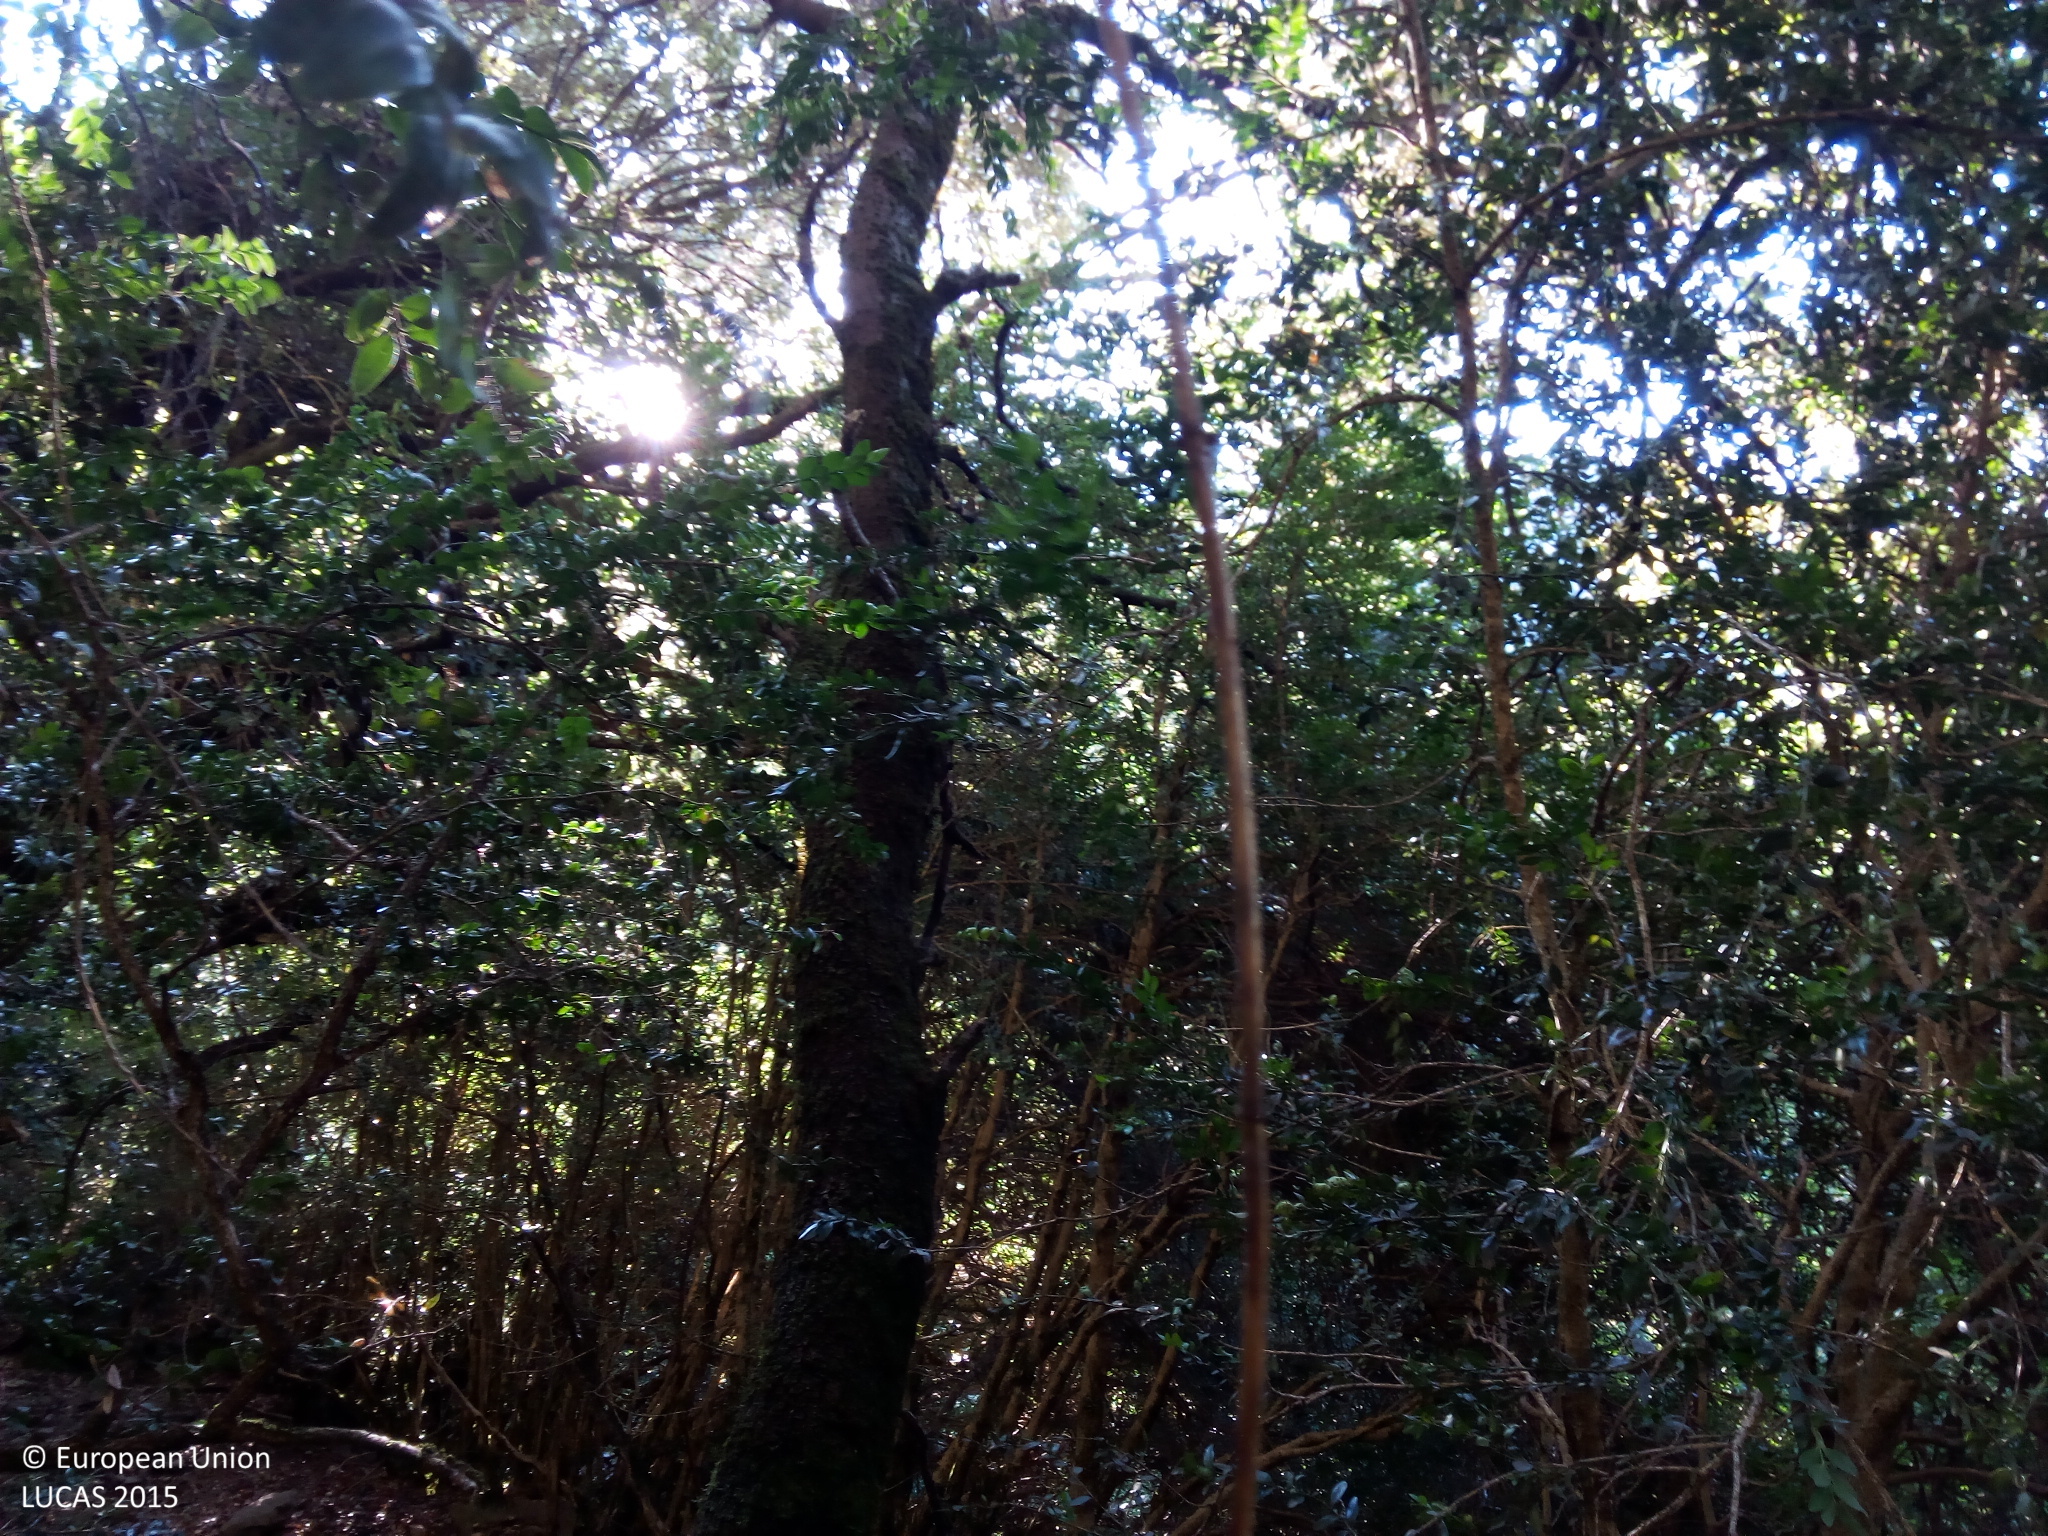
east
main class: Woodland
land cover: Broadleaved woodland
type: broadleaved evergreen forest
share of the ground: > 75 %
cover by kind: broadleaved forest trees 100 %
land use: Semi-natural and natural areas not in use
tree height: > 5 m
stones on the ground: 25 - 50 %
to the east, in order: Broadleaved woodland
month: August
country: ES
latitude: 42.5926
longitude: 0.1675
